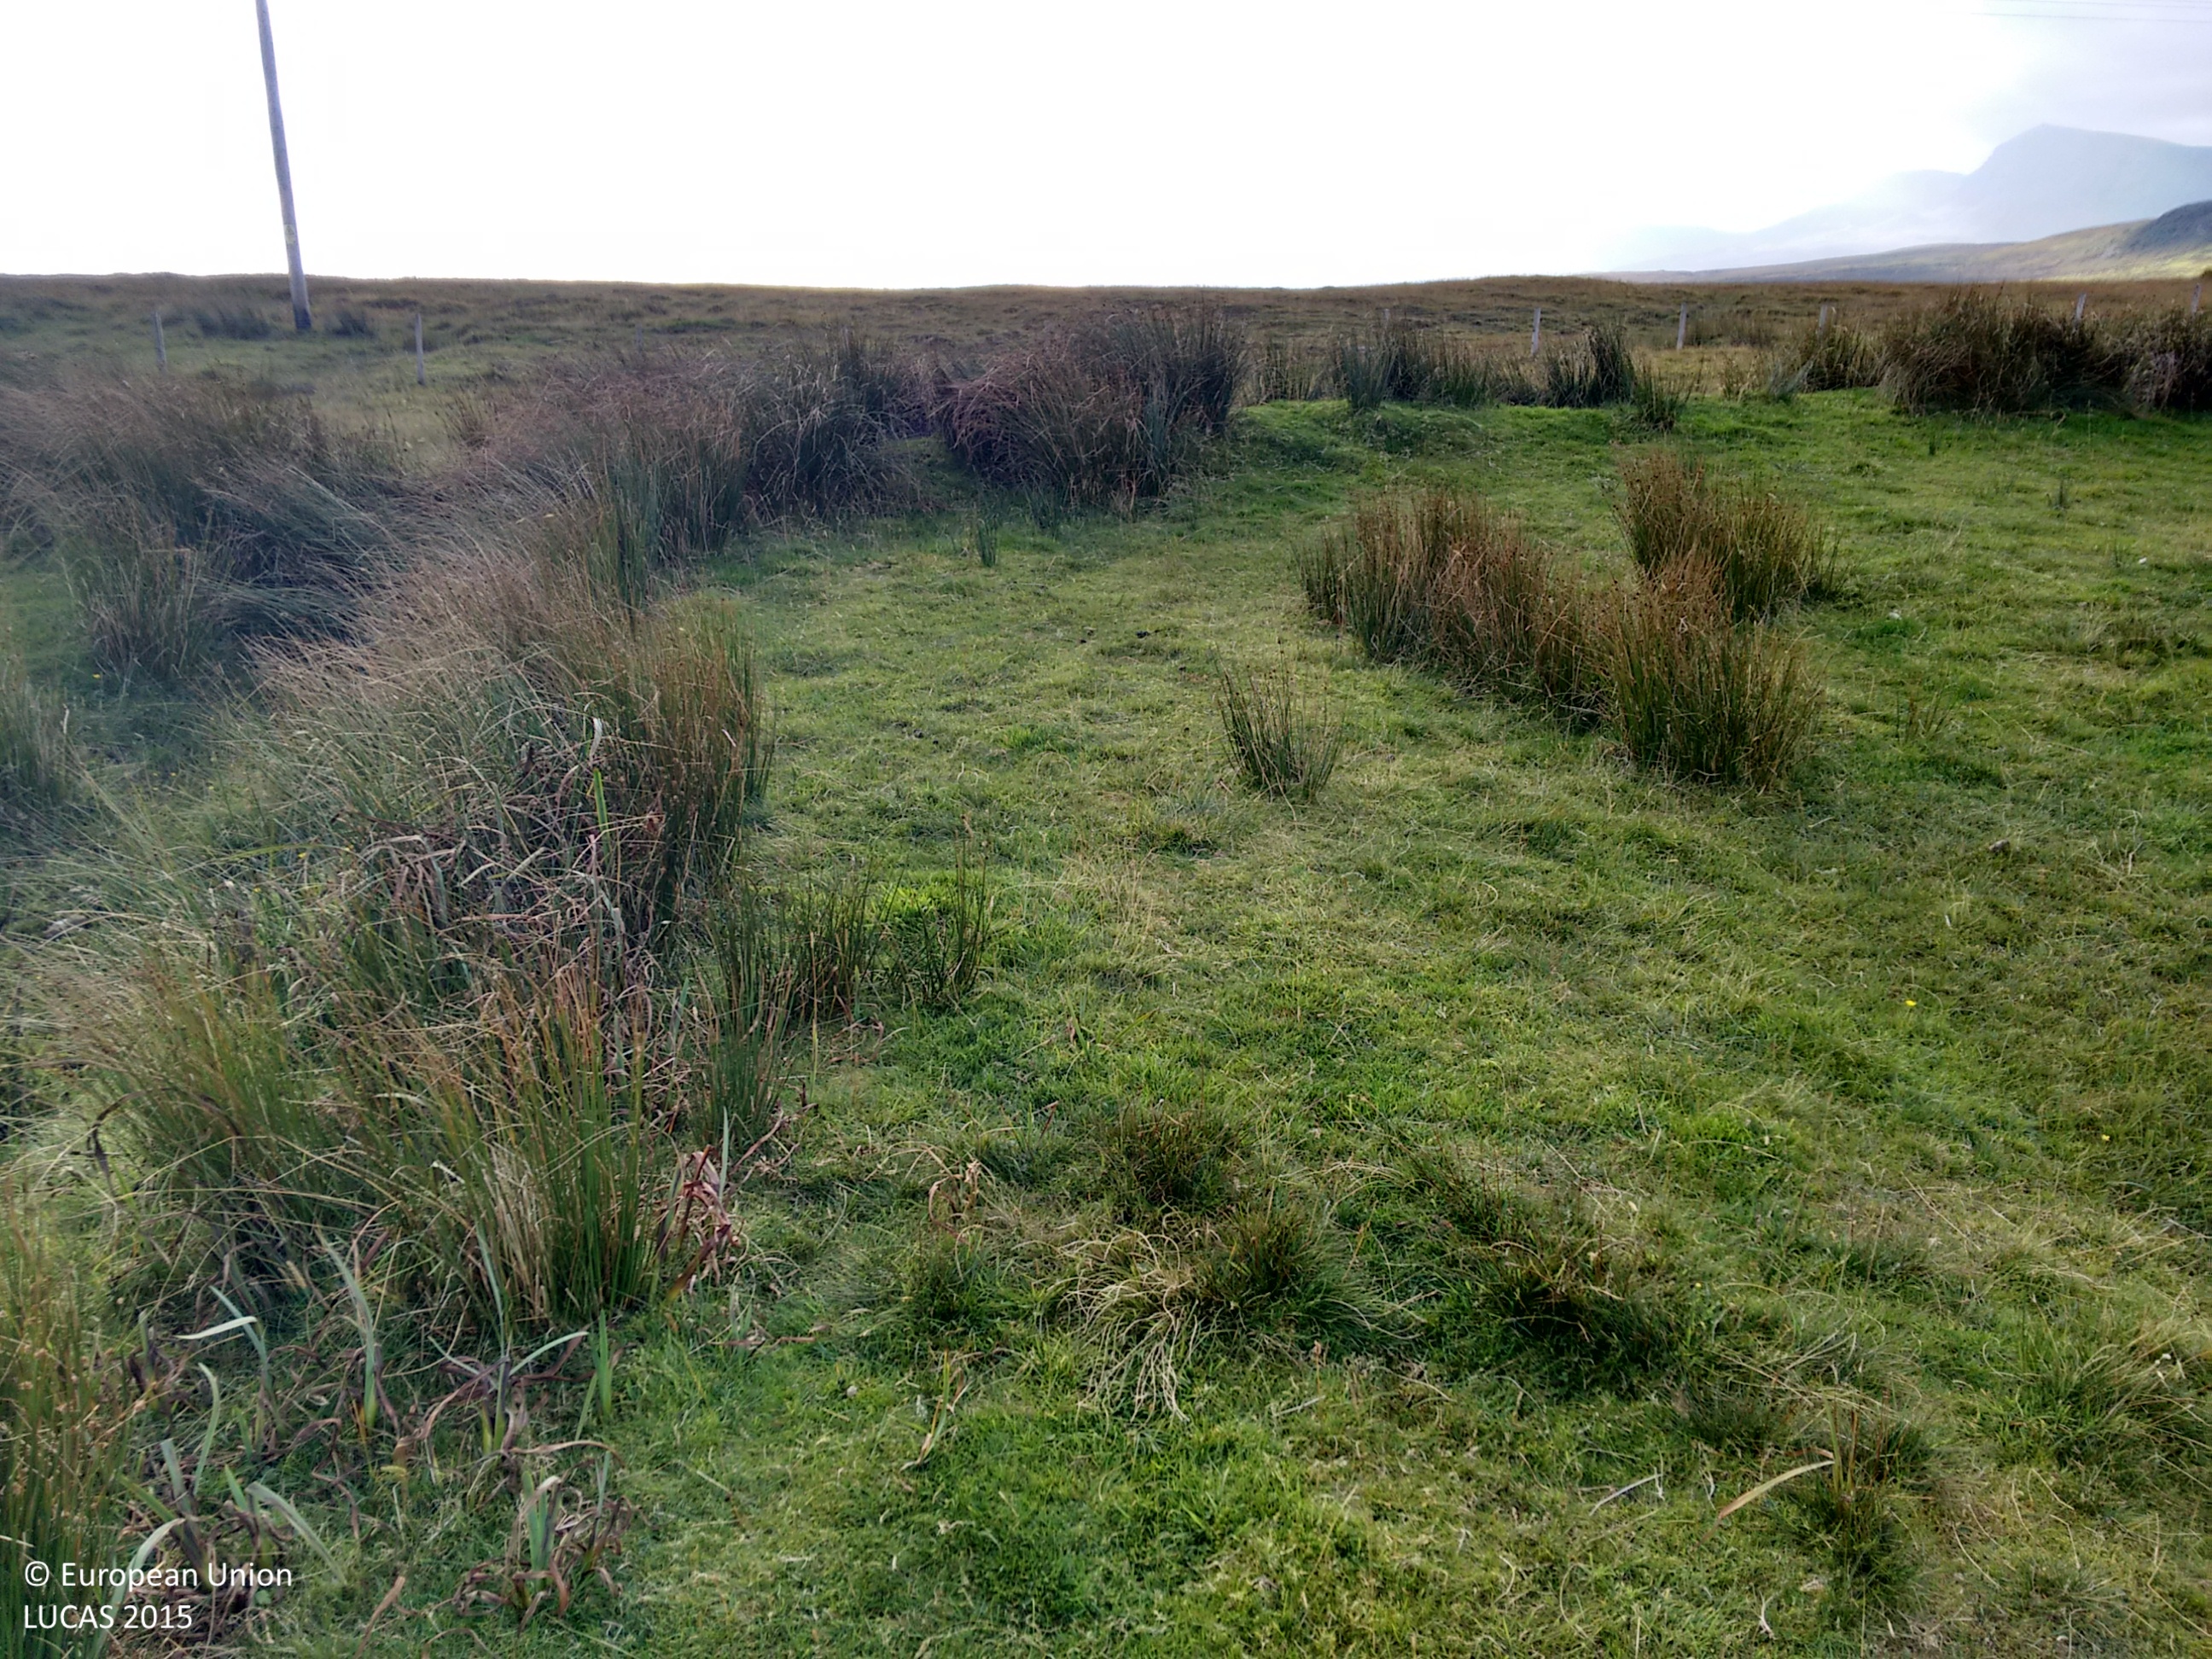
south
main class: Grassland
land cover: Grassland without tree/shrub cover
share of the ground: > 75 %
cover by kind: herbaceous plants 100 %
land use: Agriculture (excluding fallow land and kitchen gardens)
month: September
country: GB
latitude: 57.6281
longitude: -6.2268
